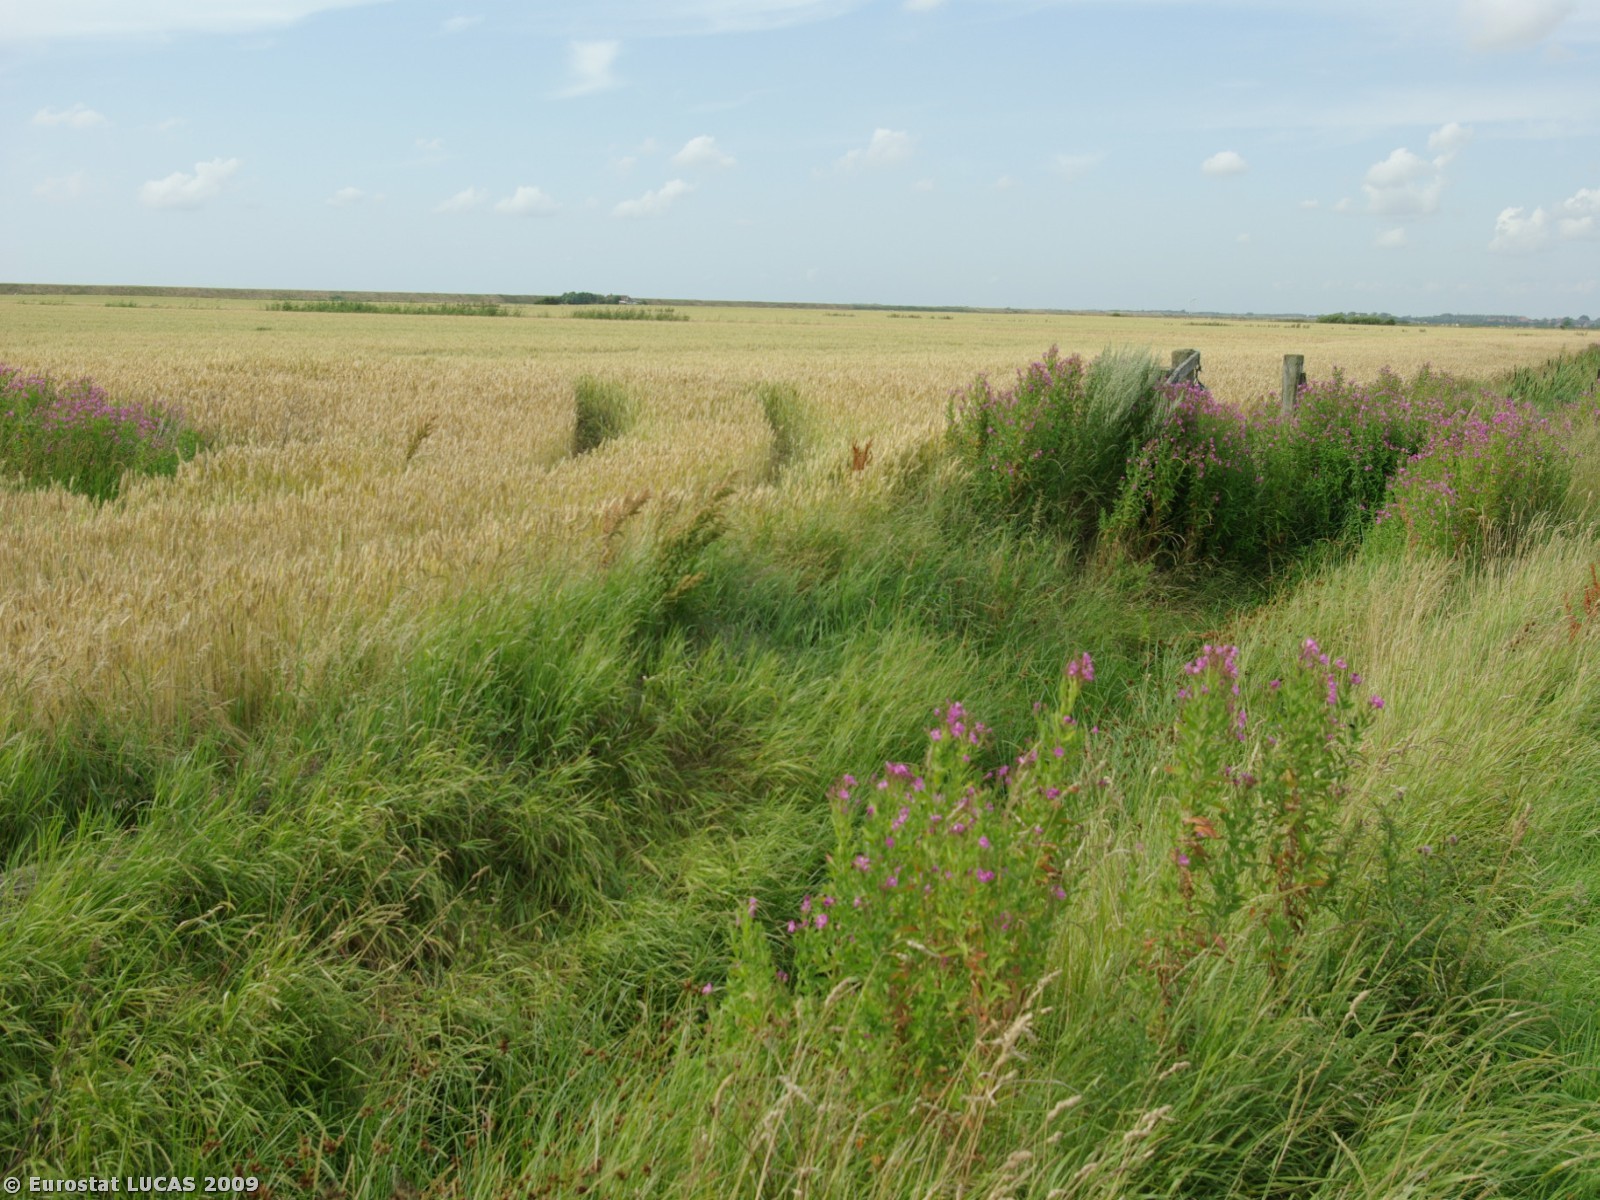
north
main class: Cropland
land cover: Common wheat
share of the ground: > 75 %
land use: Agriculture (excluding fallow land and kitchen gardens)
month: July
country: DK
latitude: 54.9225
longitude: 8.6747
